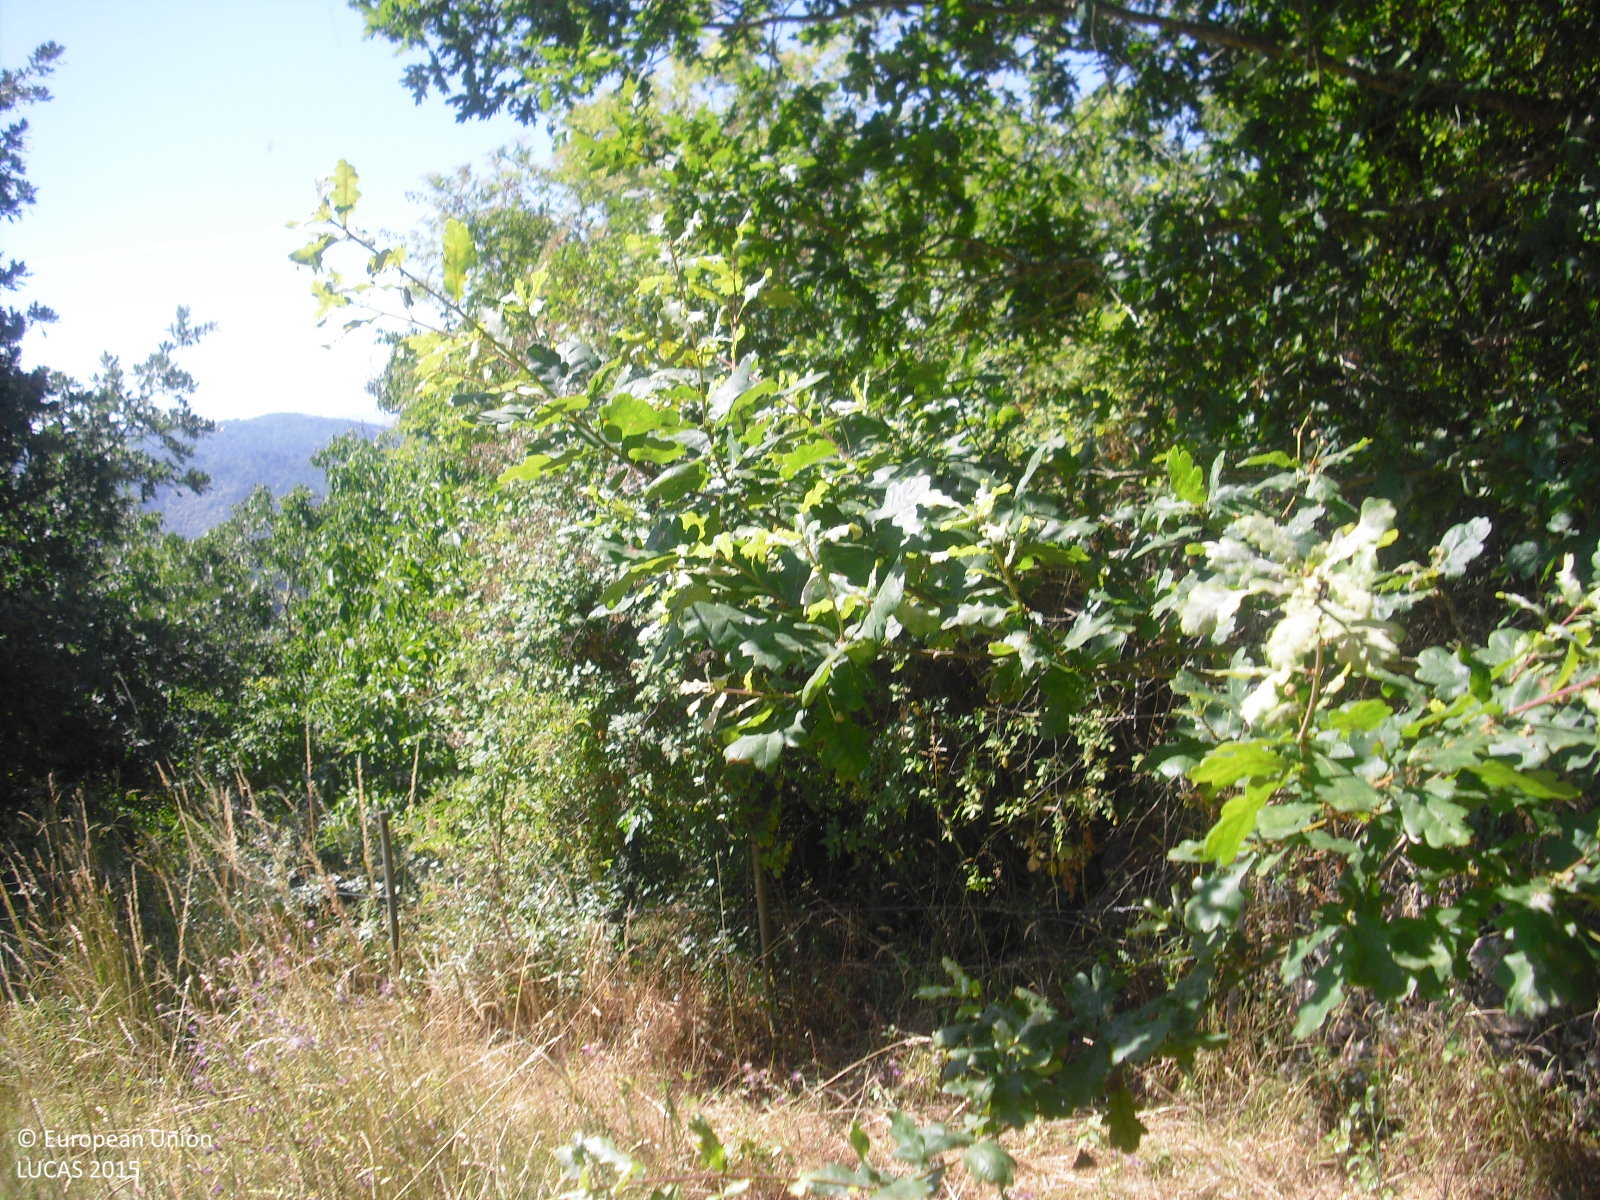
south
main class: Grassland
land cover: Grassland without tree/shrub cover
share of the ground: > 75 %
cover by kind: herbaceous plants 100 %
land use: Agriculture (excluding fallow land and kitchen gardens)
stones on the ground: < 10 %
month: July
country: ES
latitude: 42.5736
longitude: -7.7043
